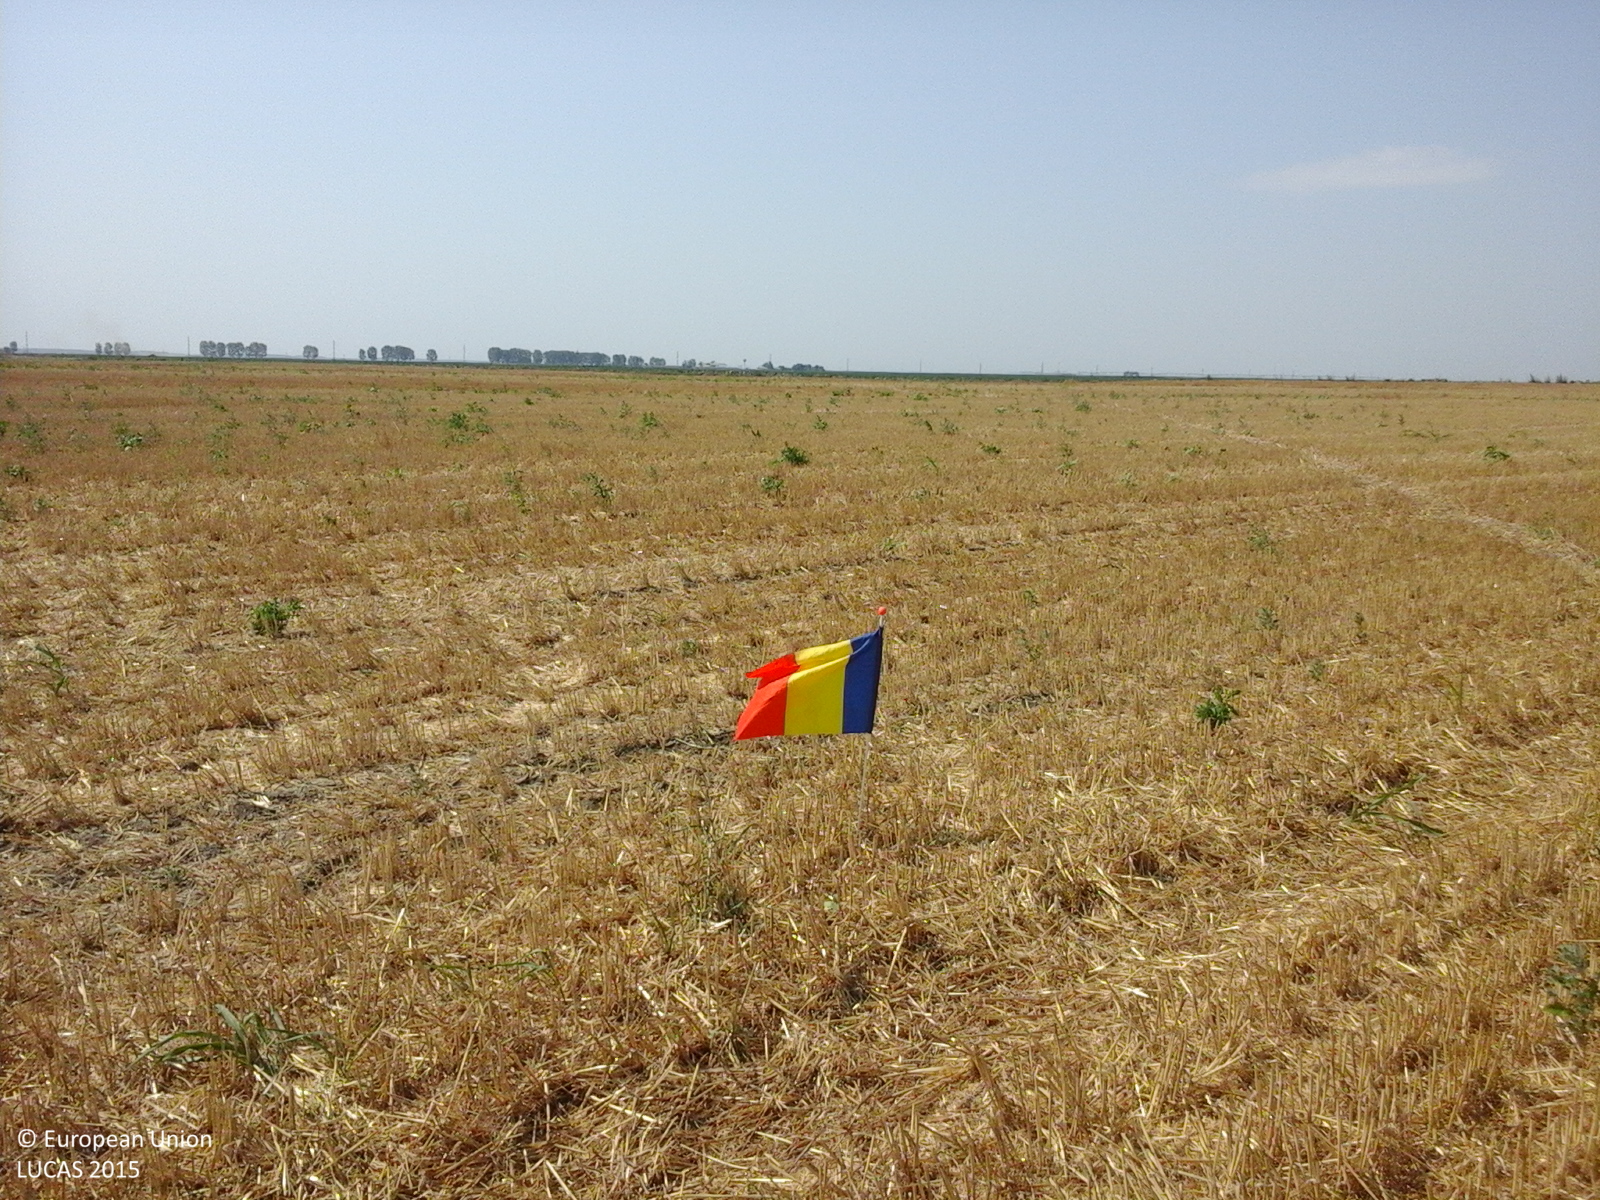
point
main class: Cropland
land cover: Common wheat
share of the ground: 50 - 75 %
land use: Agriculture (excluding fallow land and kitchen gardens)
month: August
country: RO
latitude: 44.9818
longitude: 28.0593
